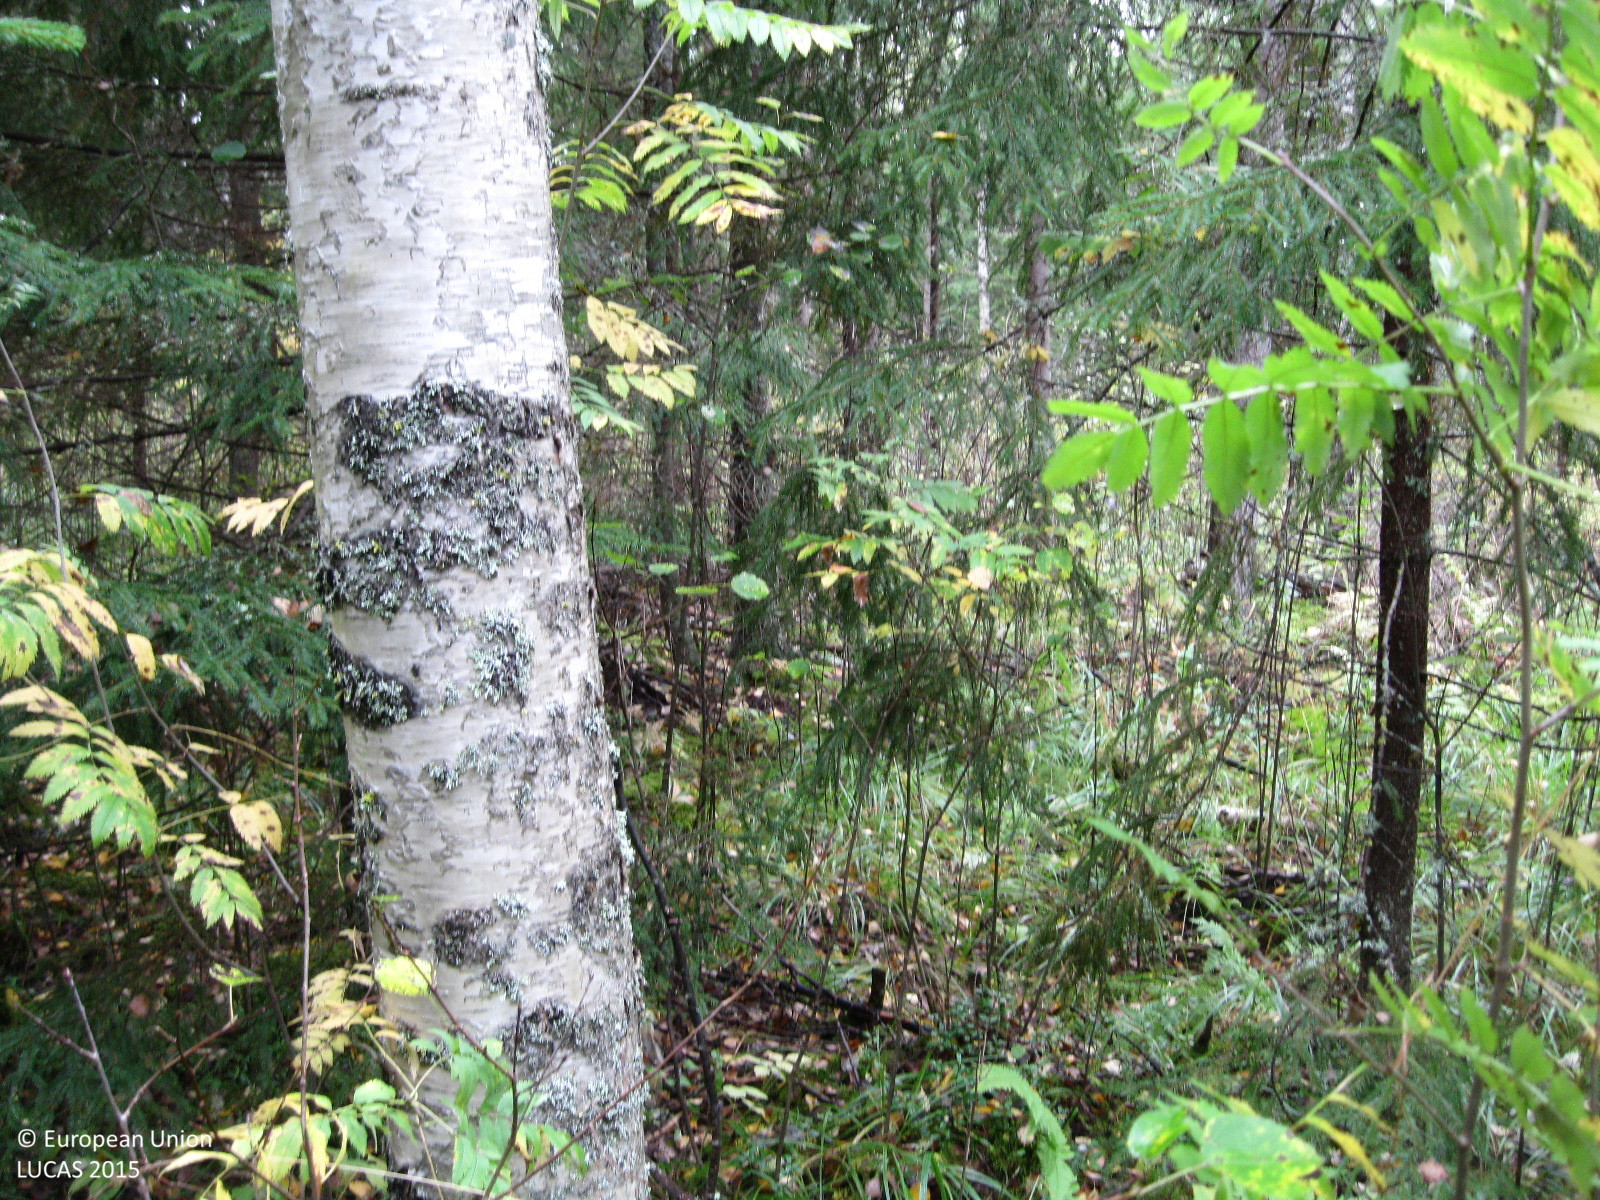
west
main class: Woodland
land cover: Spruce dominated mixed woodland
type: boreal forest
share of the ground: 50 - 75 %
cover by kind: coniferous forest trees 50 %, broadleaved forest trees 20 %, herbaceous plants 20 %, shrubs 5 %, lichens and mosses 5 %
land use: Forestry
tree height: > 5 m
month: September
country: FI
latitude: 60.8612
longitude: 24.8207
